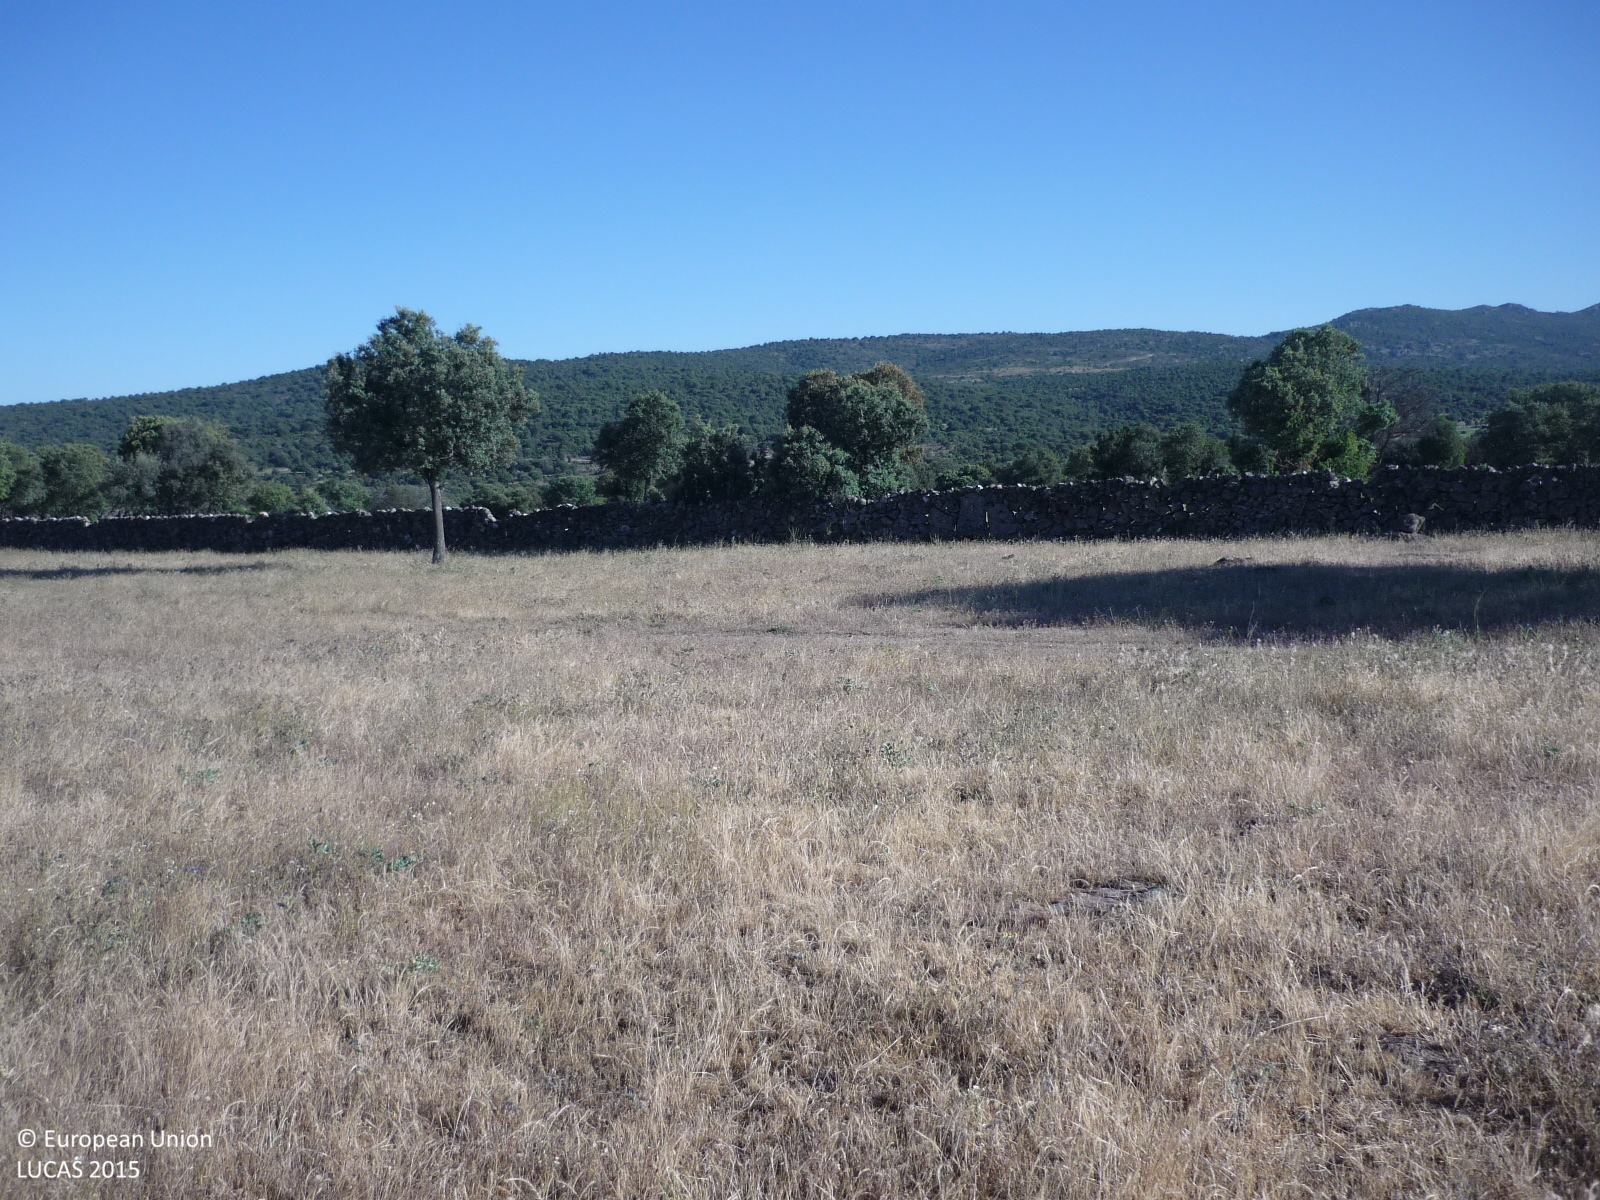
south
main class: Grassland
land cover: Grassland with sparse tree/shrub cover
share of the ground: > 75 %
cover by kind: herbaceous plants 90 %, broadleaved forest trees 5 %, shrubs 5 %
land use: Agriculture (excluding fallow land and kitchen gardens)
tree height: < 5 m
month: May
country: ES
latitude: 40.6869
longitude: -3.8758
